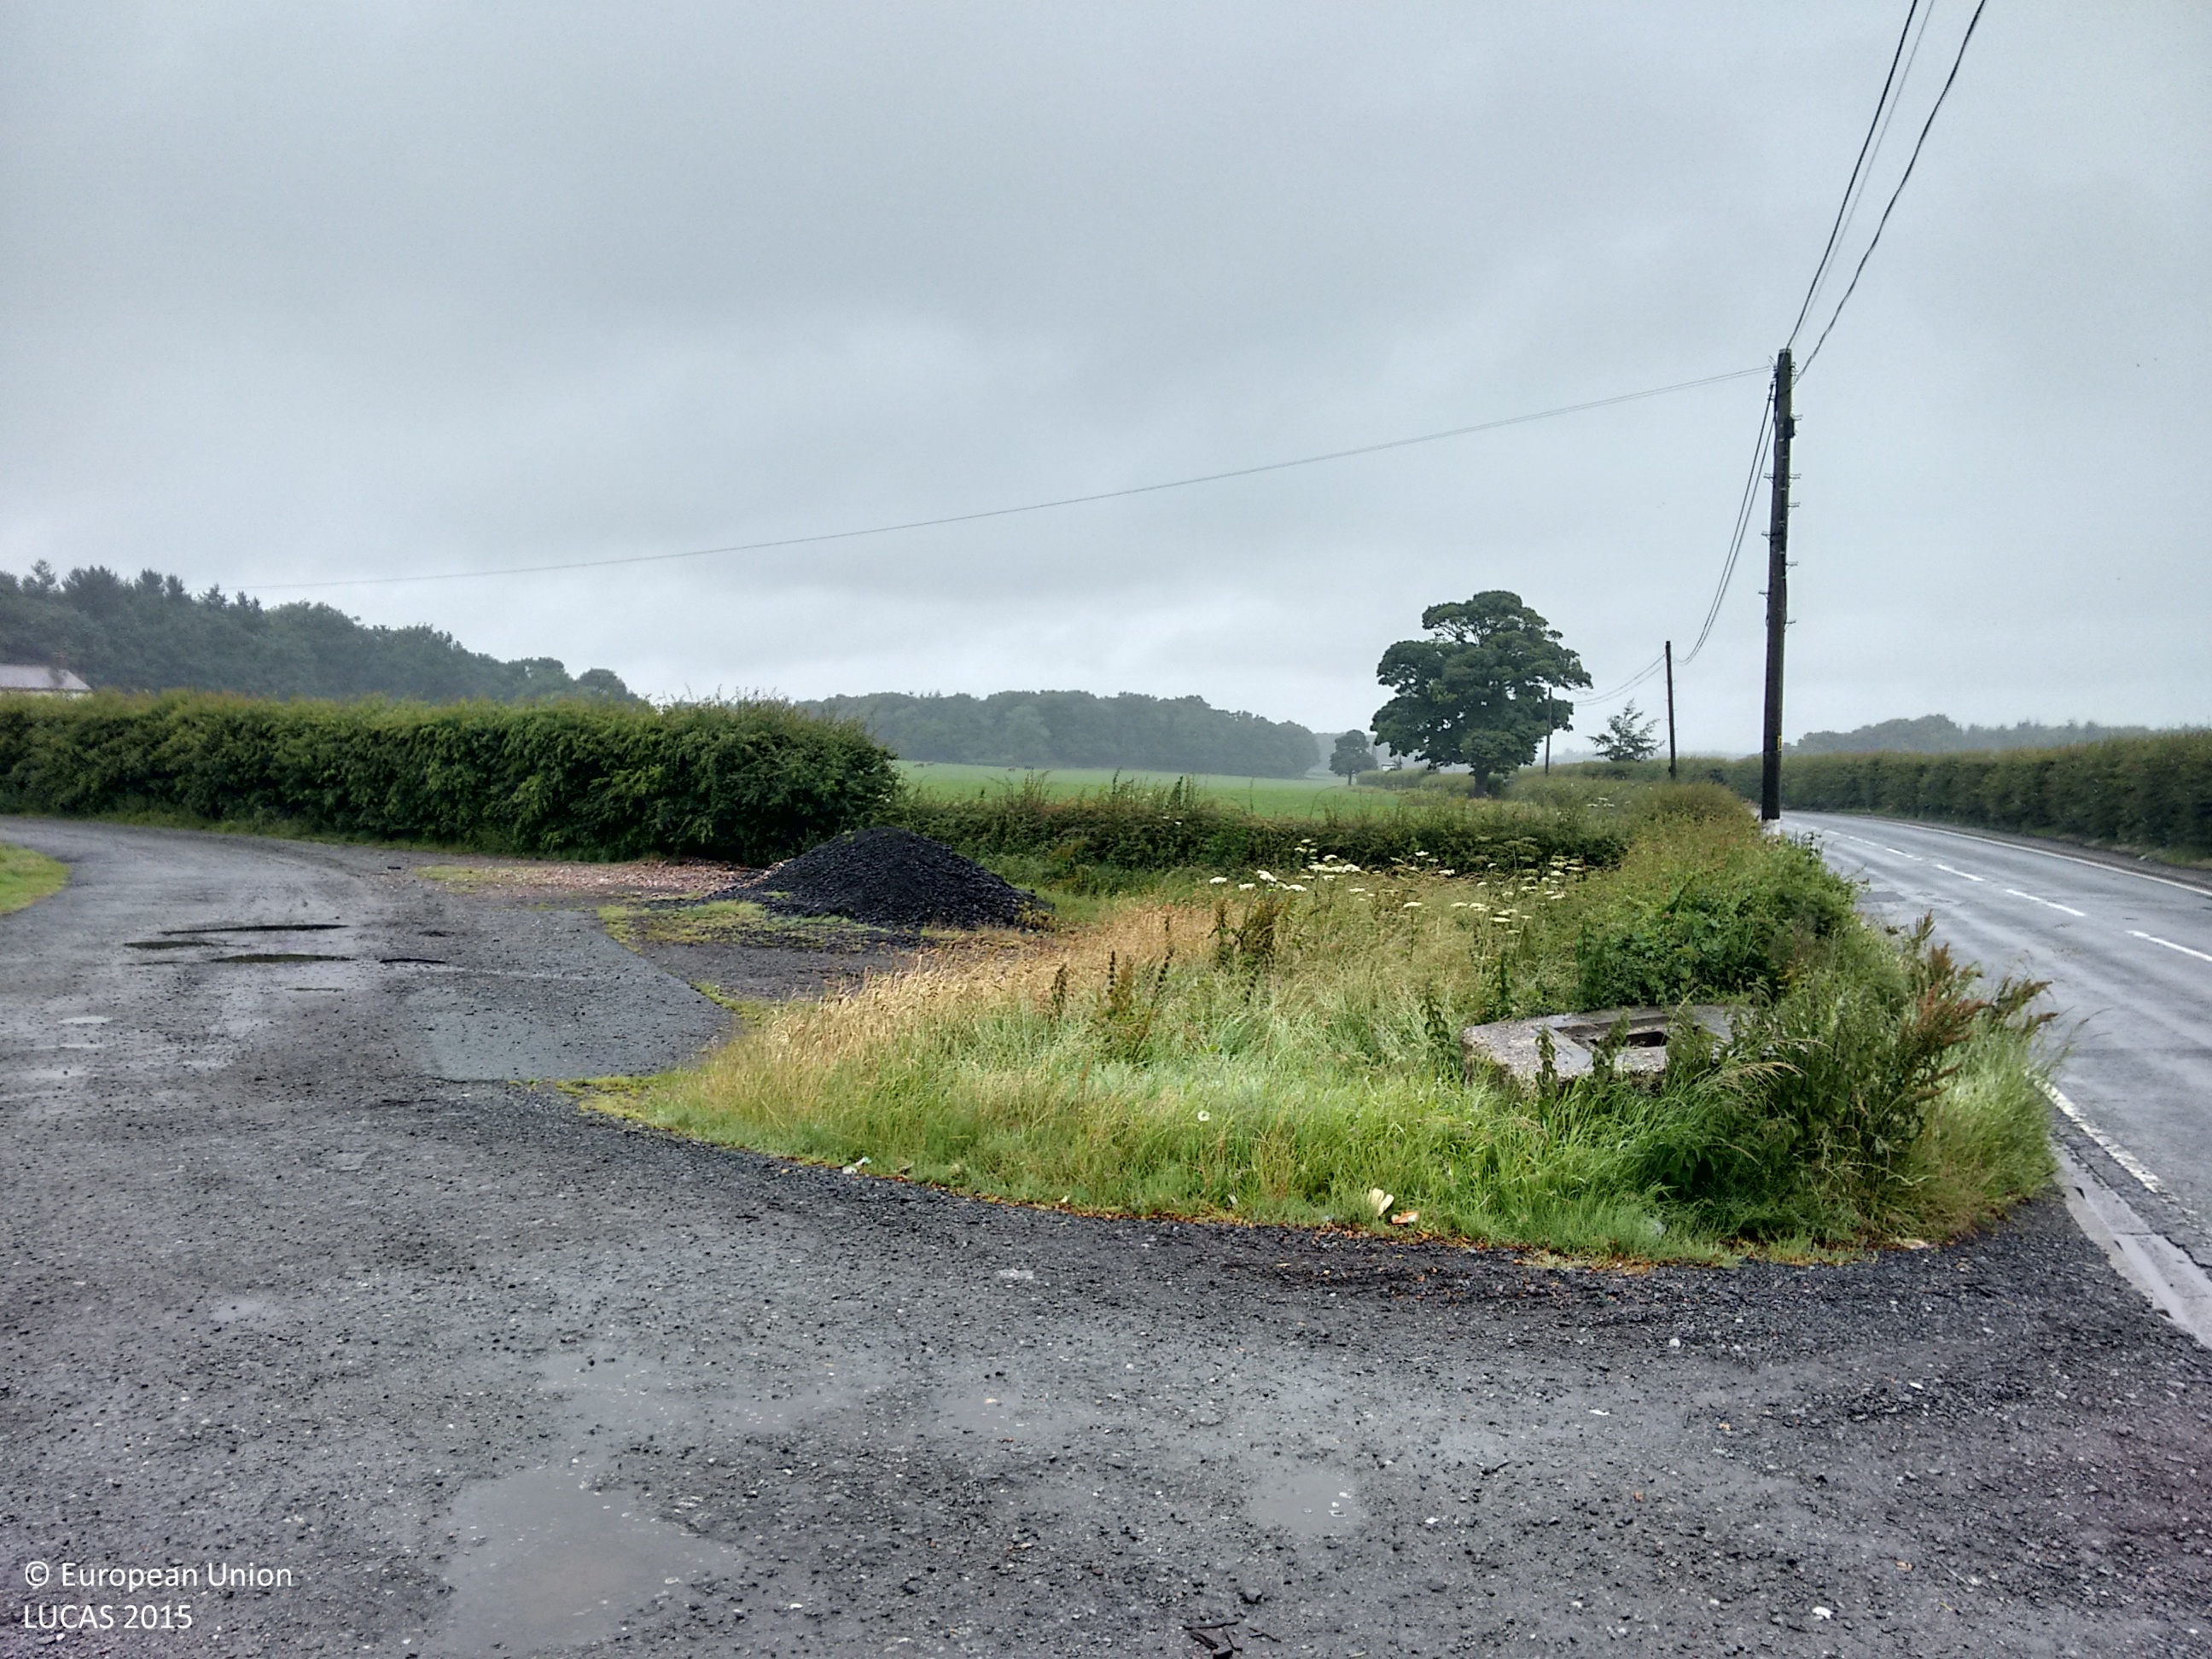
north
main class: Cropland
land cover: Potatoes
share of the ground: > 75 %
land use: Agriculture (excluding fallow land and kitchen gardens)
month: July
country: GB
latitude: 53.4836
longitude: -2.8046
